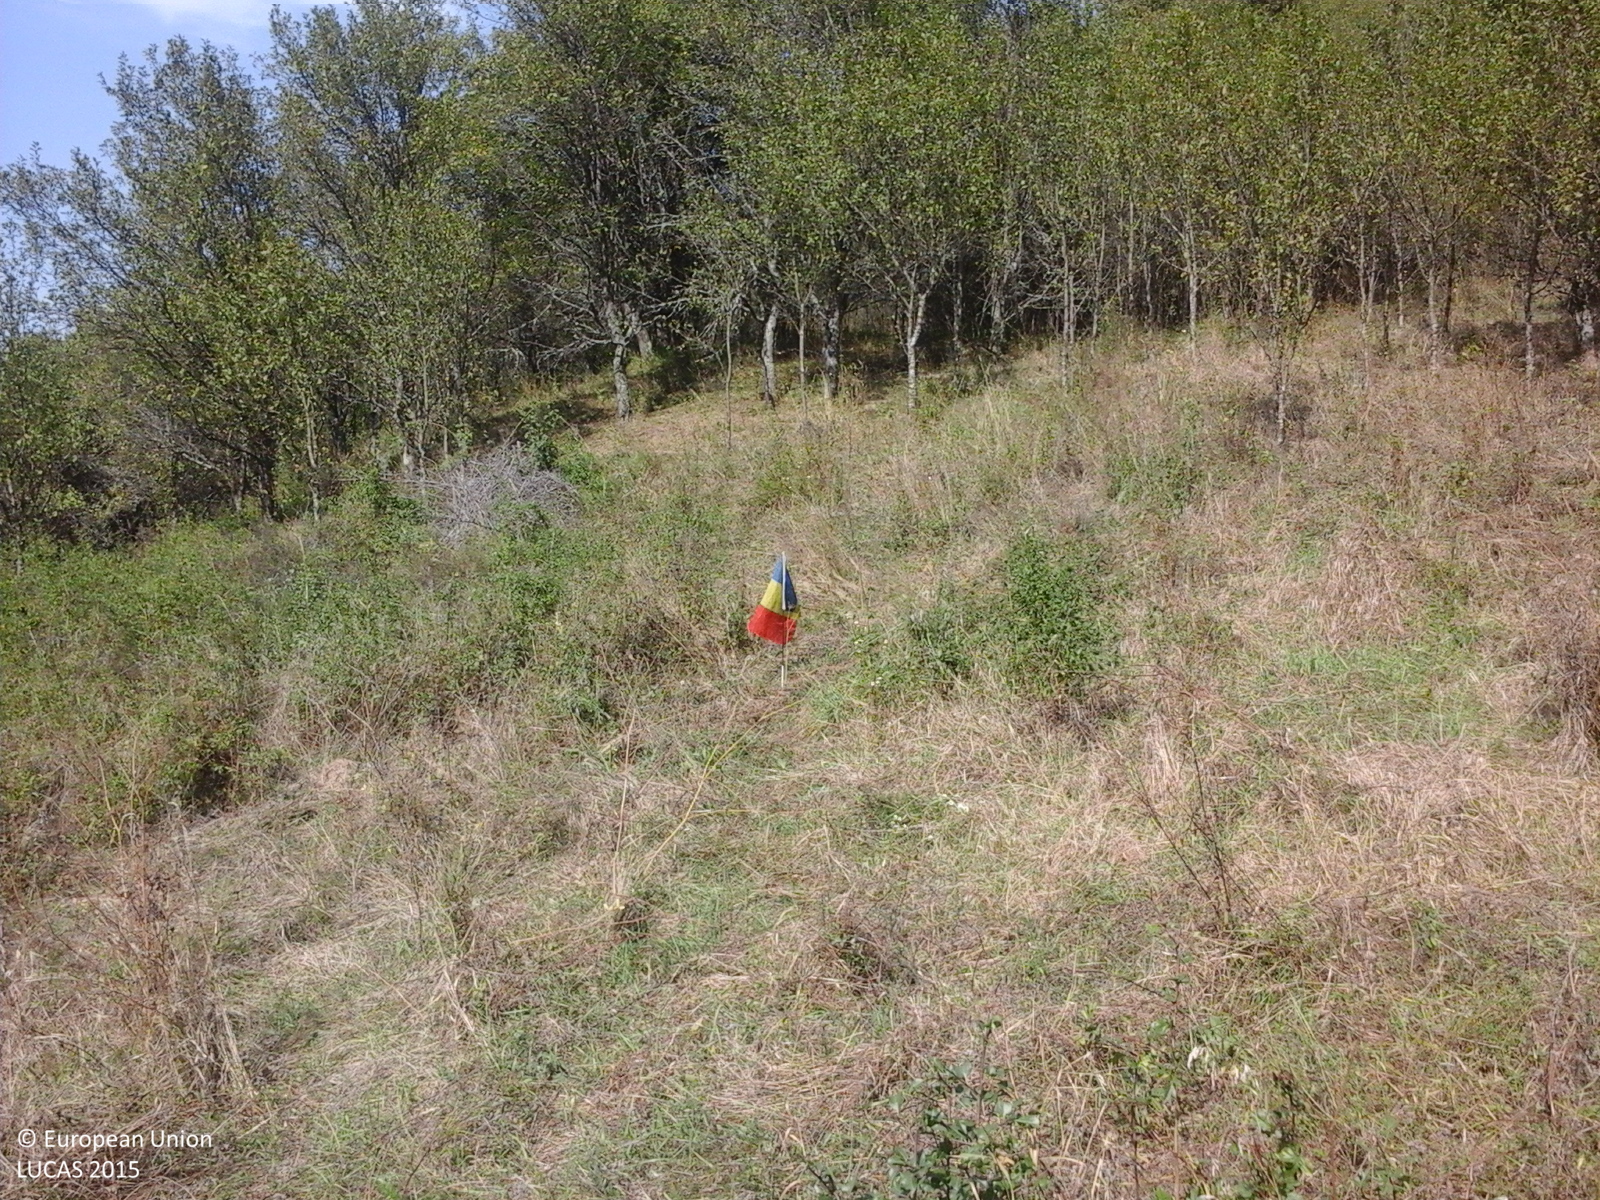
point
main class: Grassland
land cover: Spontaneously vegetated surfaces
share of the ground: > 75 %
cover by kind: herbaceous plants 100 %
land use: Fallow land
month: September
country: RO
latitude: 47.2394
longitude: 23.6686
